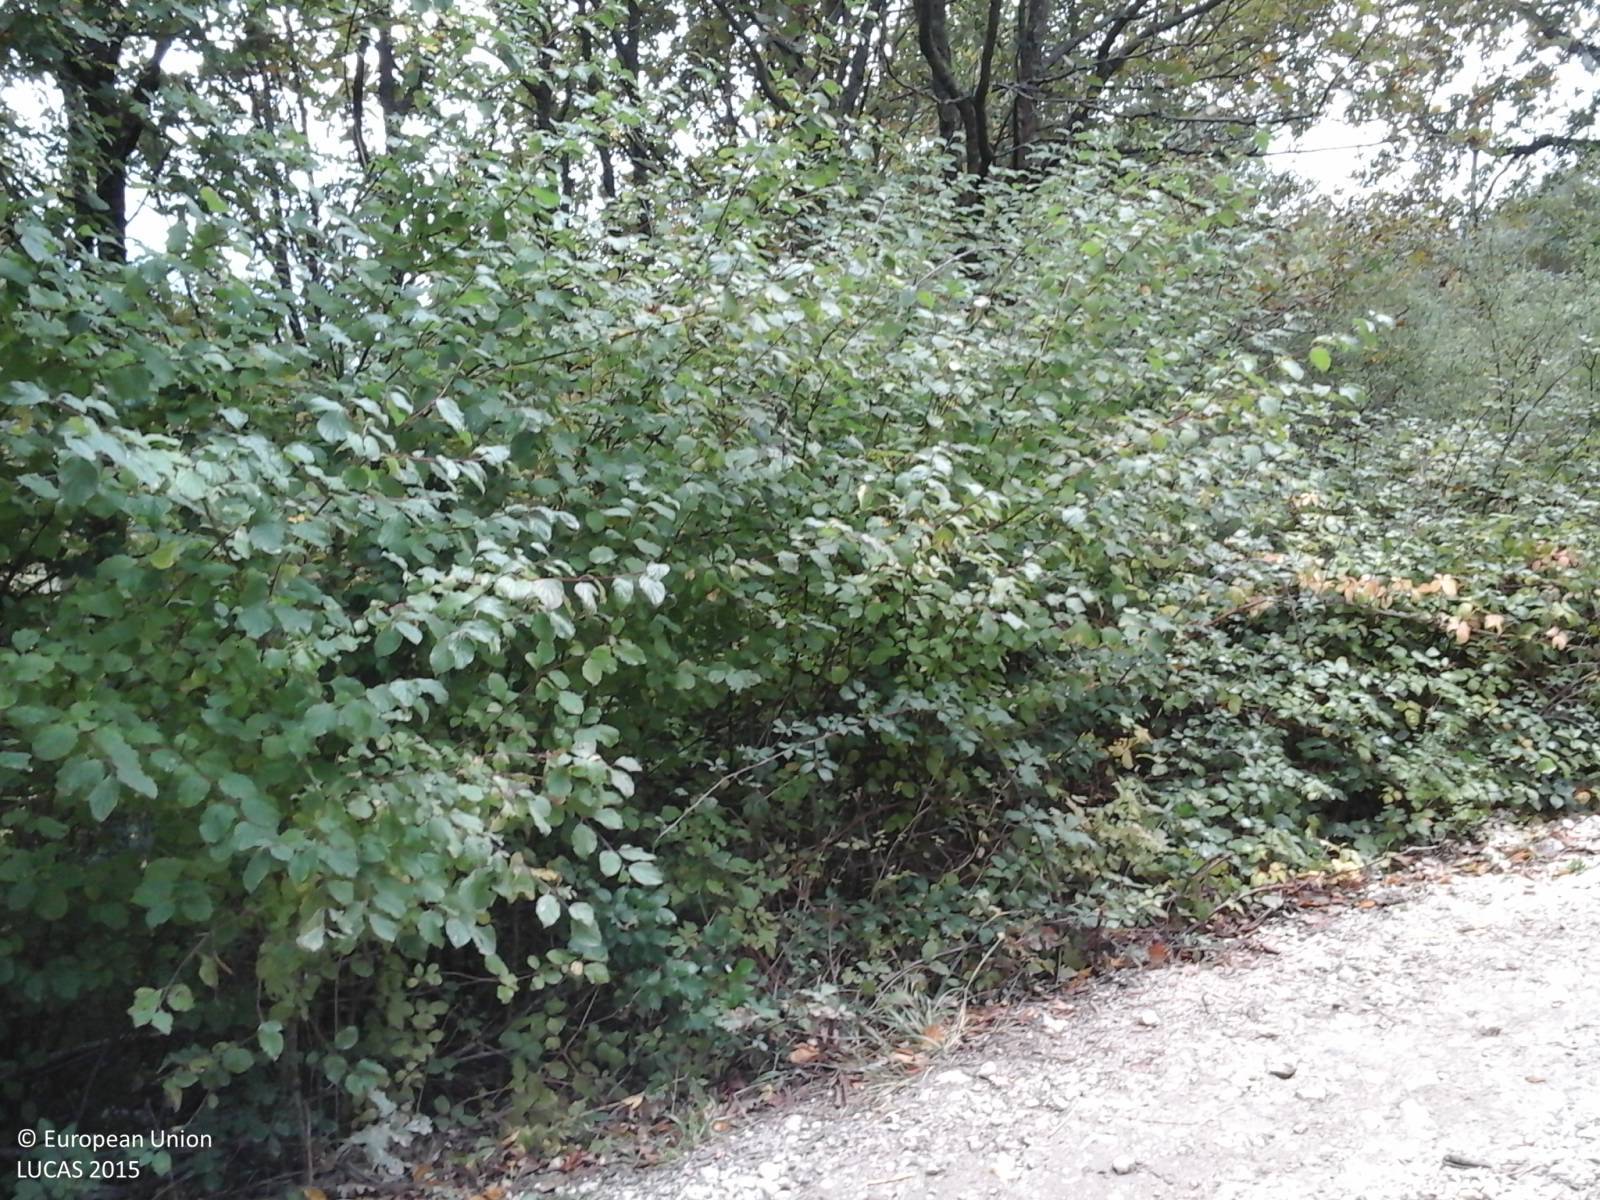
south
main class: Grassland
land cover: Grassland without tree/shrub cover
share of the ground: > 75 %
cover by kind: herbaceous plants 100 %
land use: Agriculture (excluding fallow land and kitchen gardens)
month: October
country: IT
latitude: 42.2608
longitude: 13.1776
